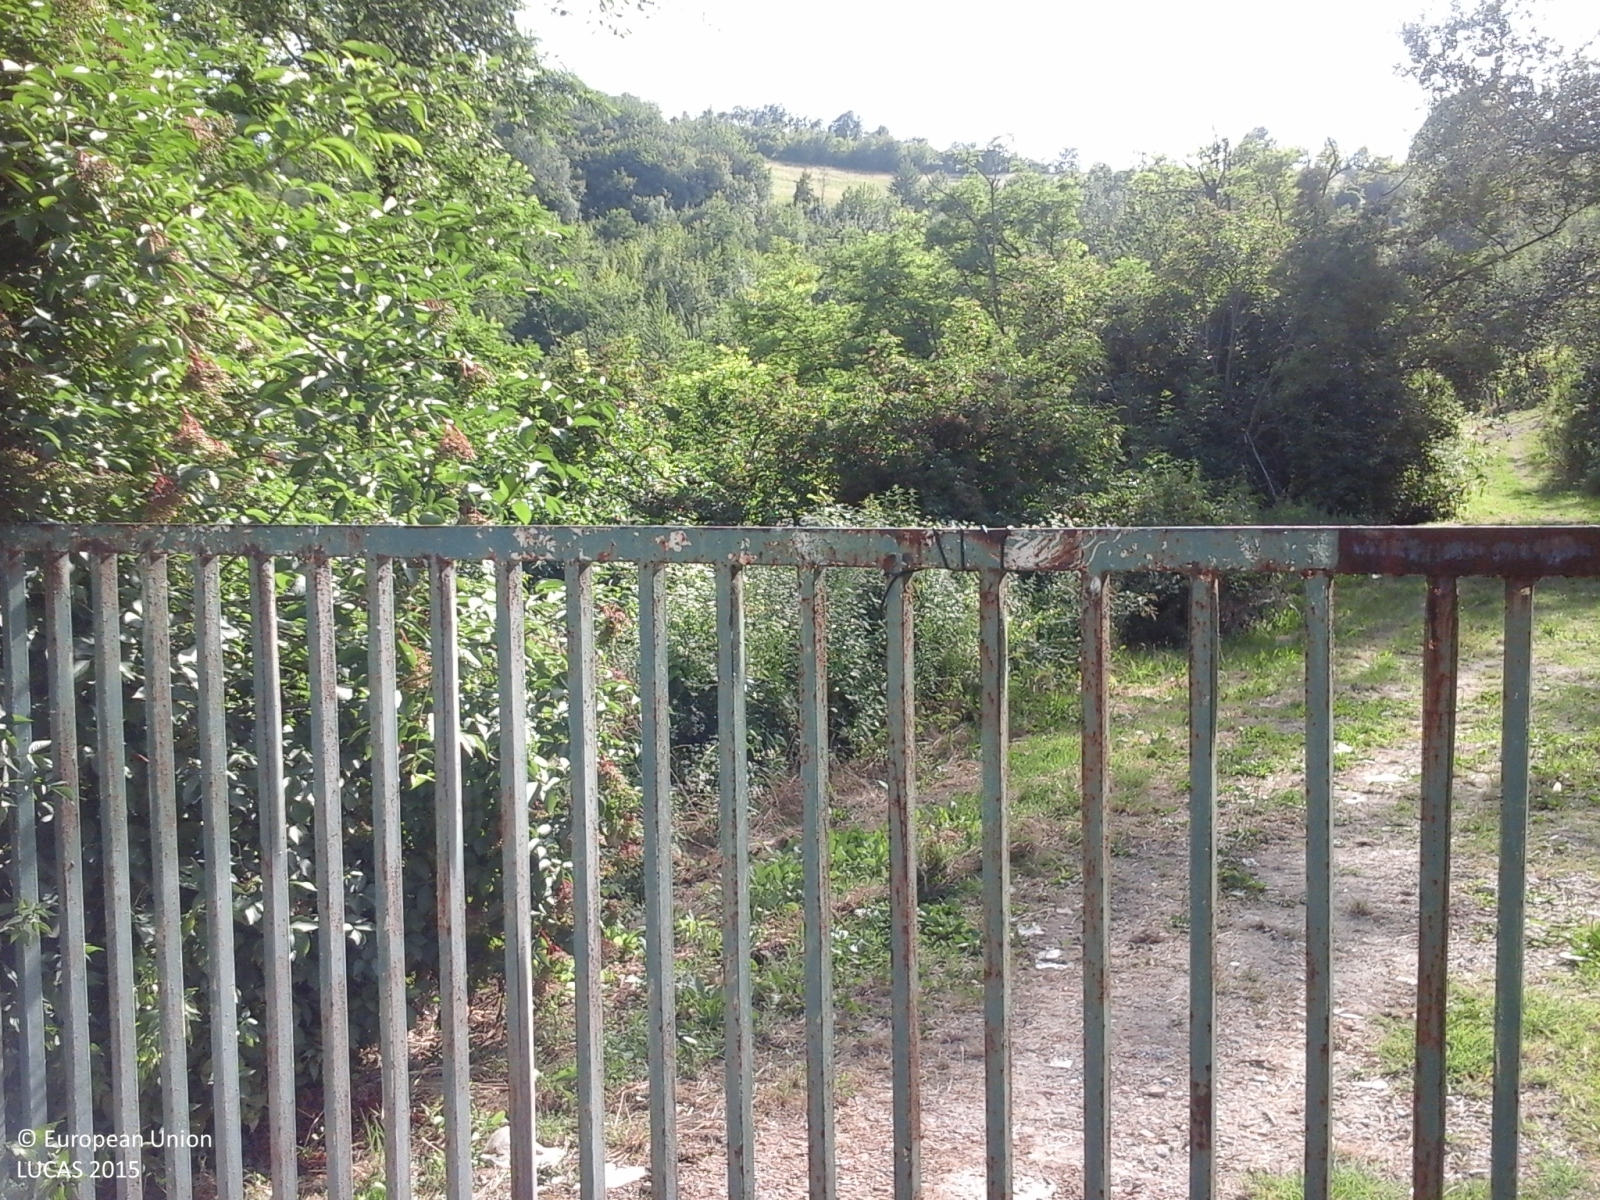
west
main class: Woodland
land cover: Broadleaved woodland
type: thermophilous deciduous forest
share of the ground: > 75 %
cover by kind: broadleaved forest trees 80 %, shrubs 10 %, consolidated bare surface 10 %
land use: Forestry
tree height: > 5 m
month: June
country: IT
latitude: 44.6759
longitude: 8.0990
